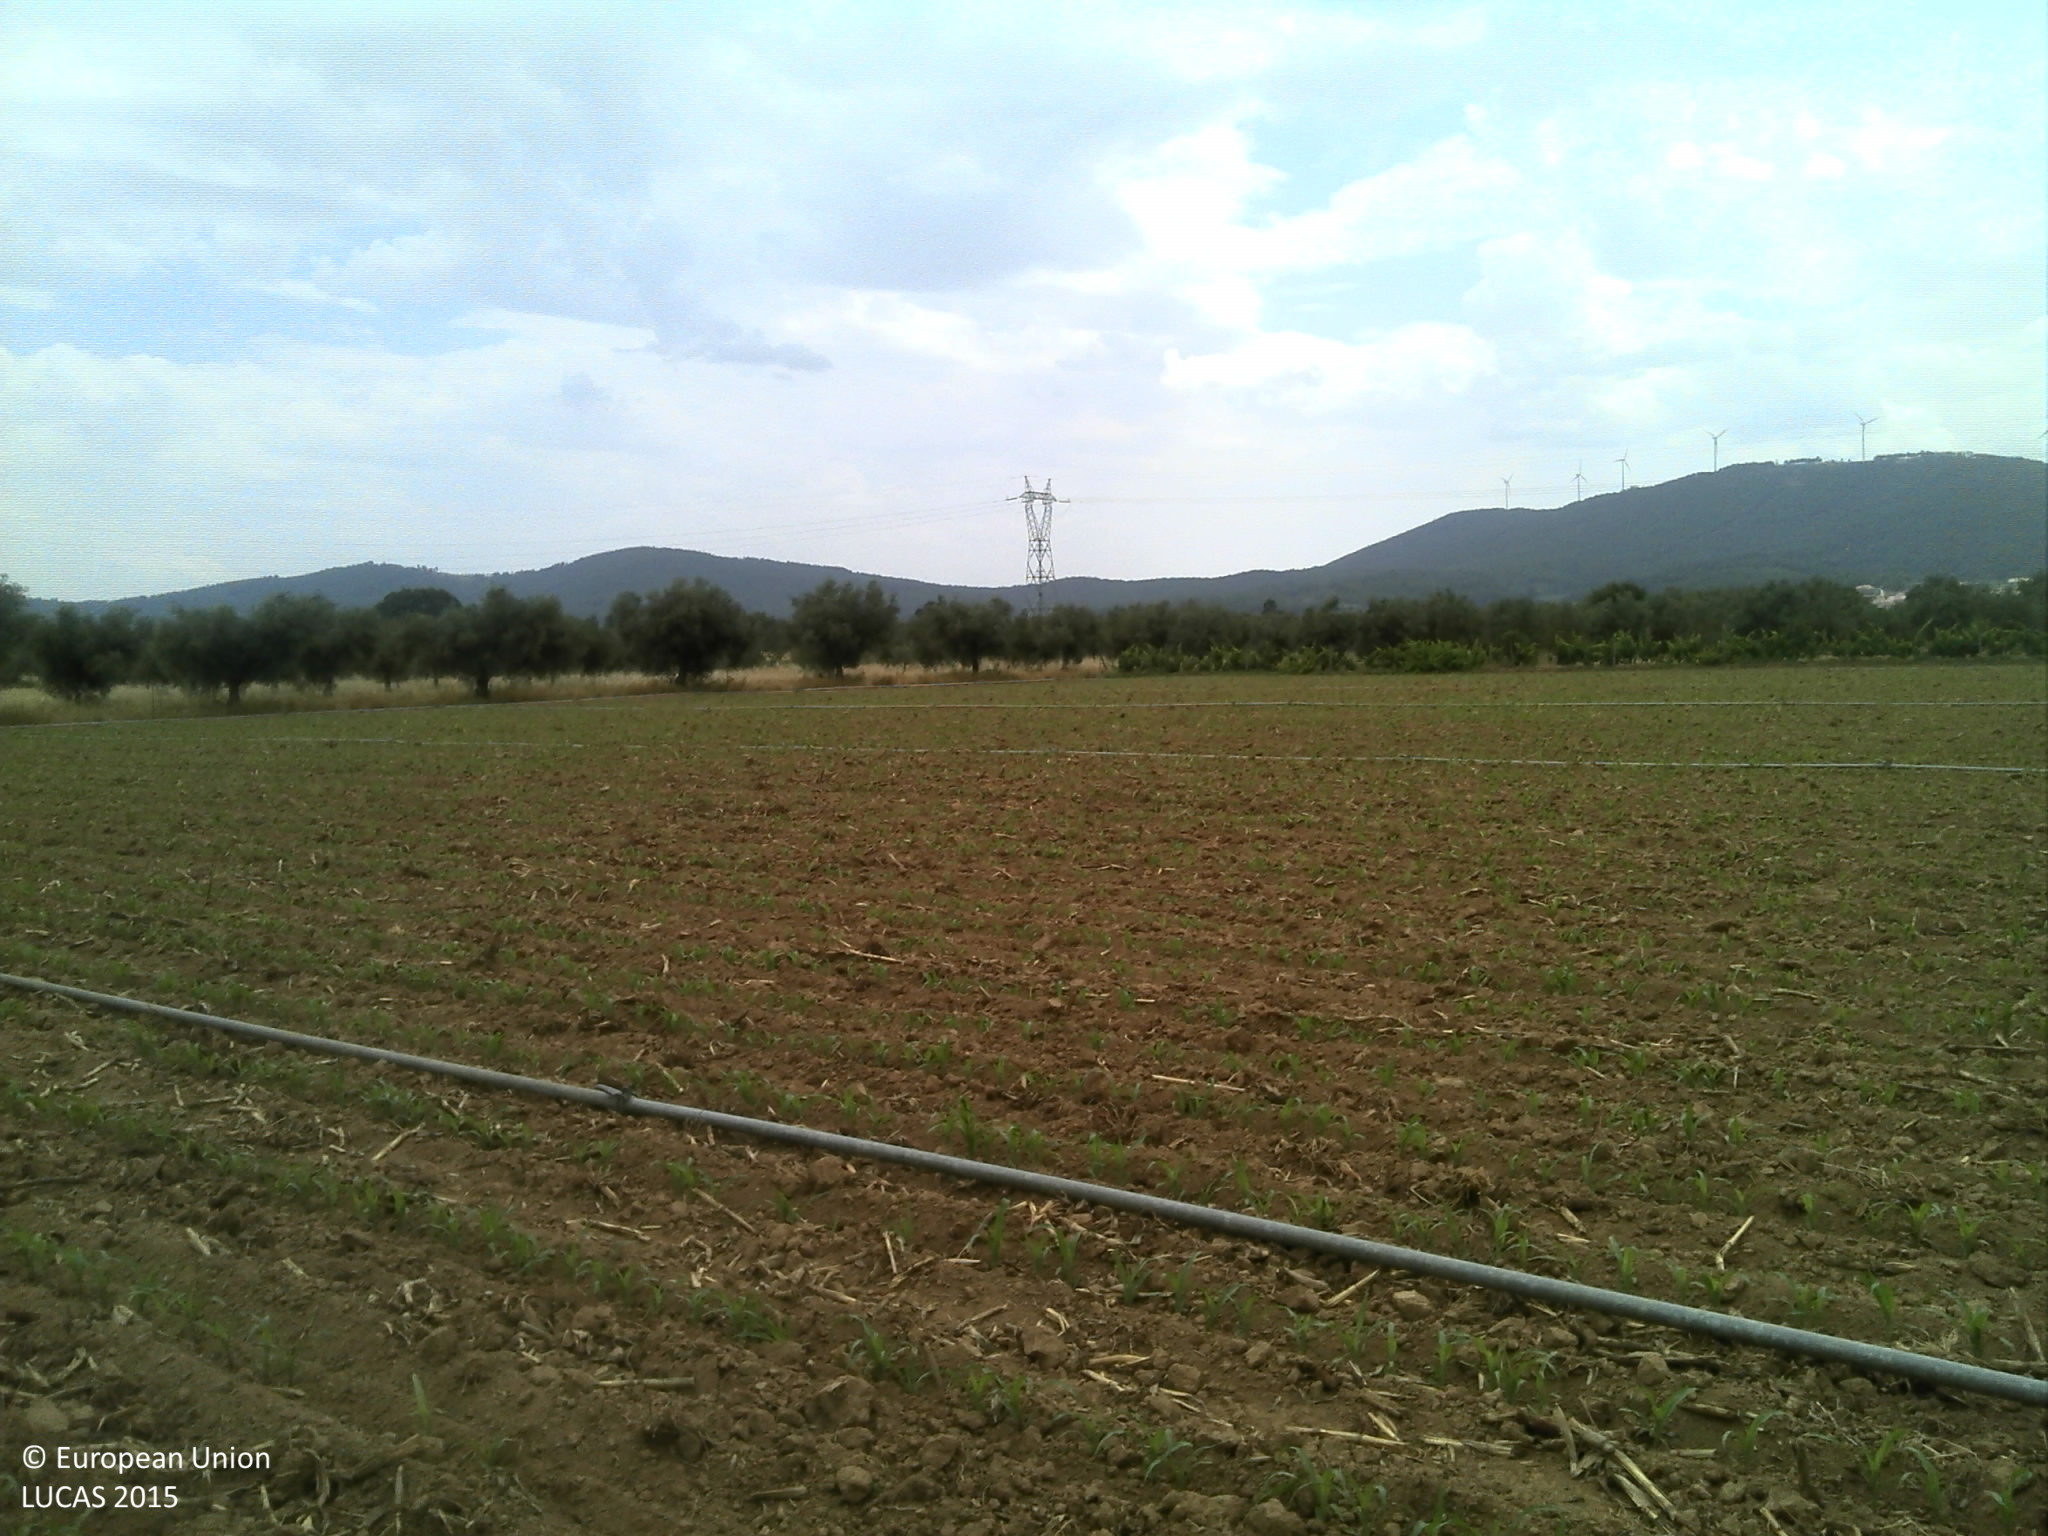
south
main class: Cropland
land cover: Maize
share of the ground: < 10 %
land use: Agriculture (excluding fallow land and kitchen gardens)
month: June
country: PT
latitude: 40.2431
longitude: -7.2270
